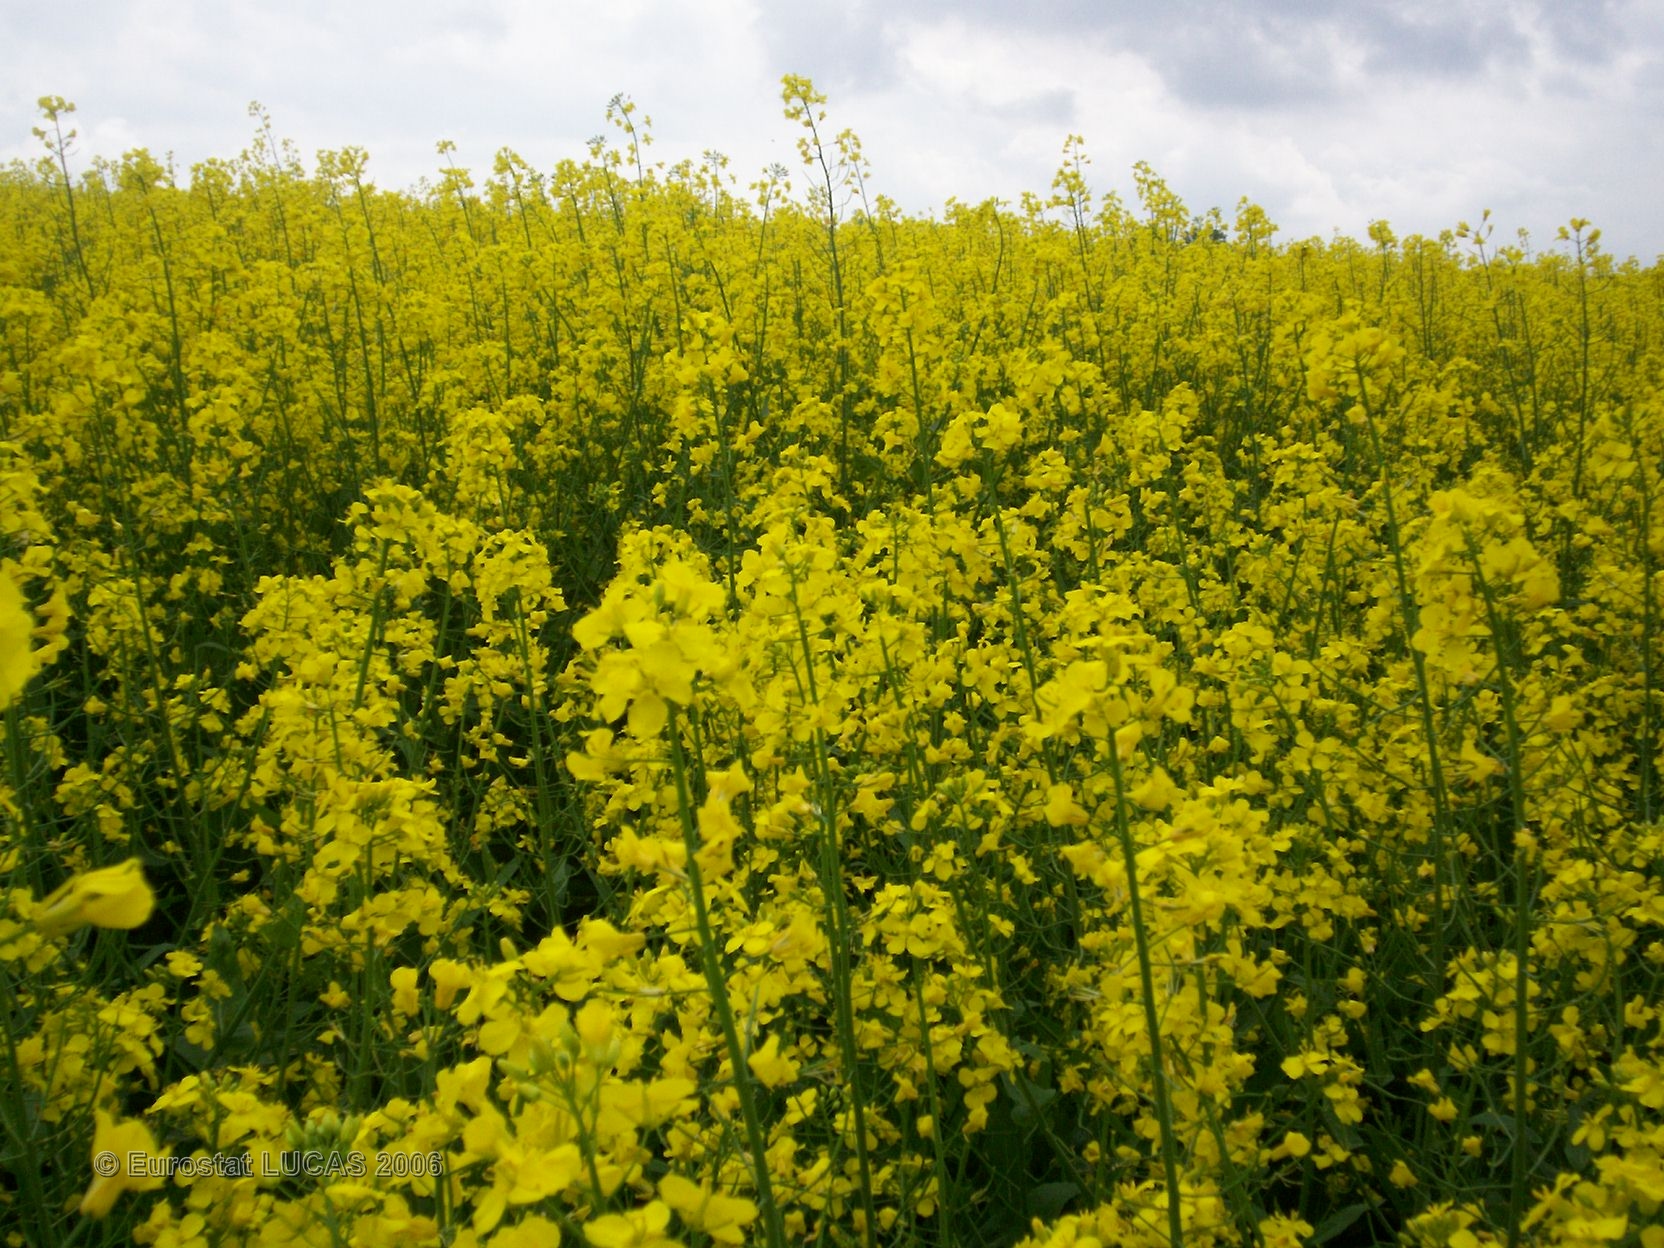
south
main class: Cropland
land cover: Rape and turnip rape
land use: Agriculture (excluding fallow land and kitchen gardens)
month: May
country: FR
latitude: 49.4074
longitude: 6.4027
